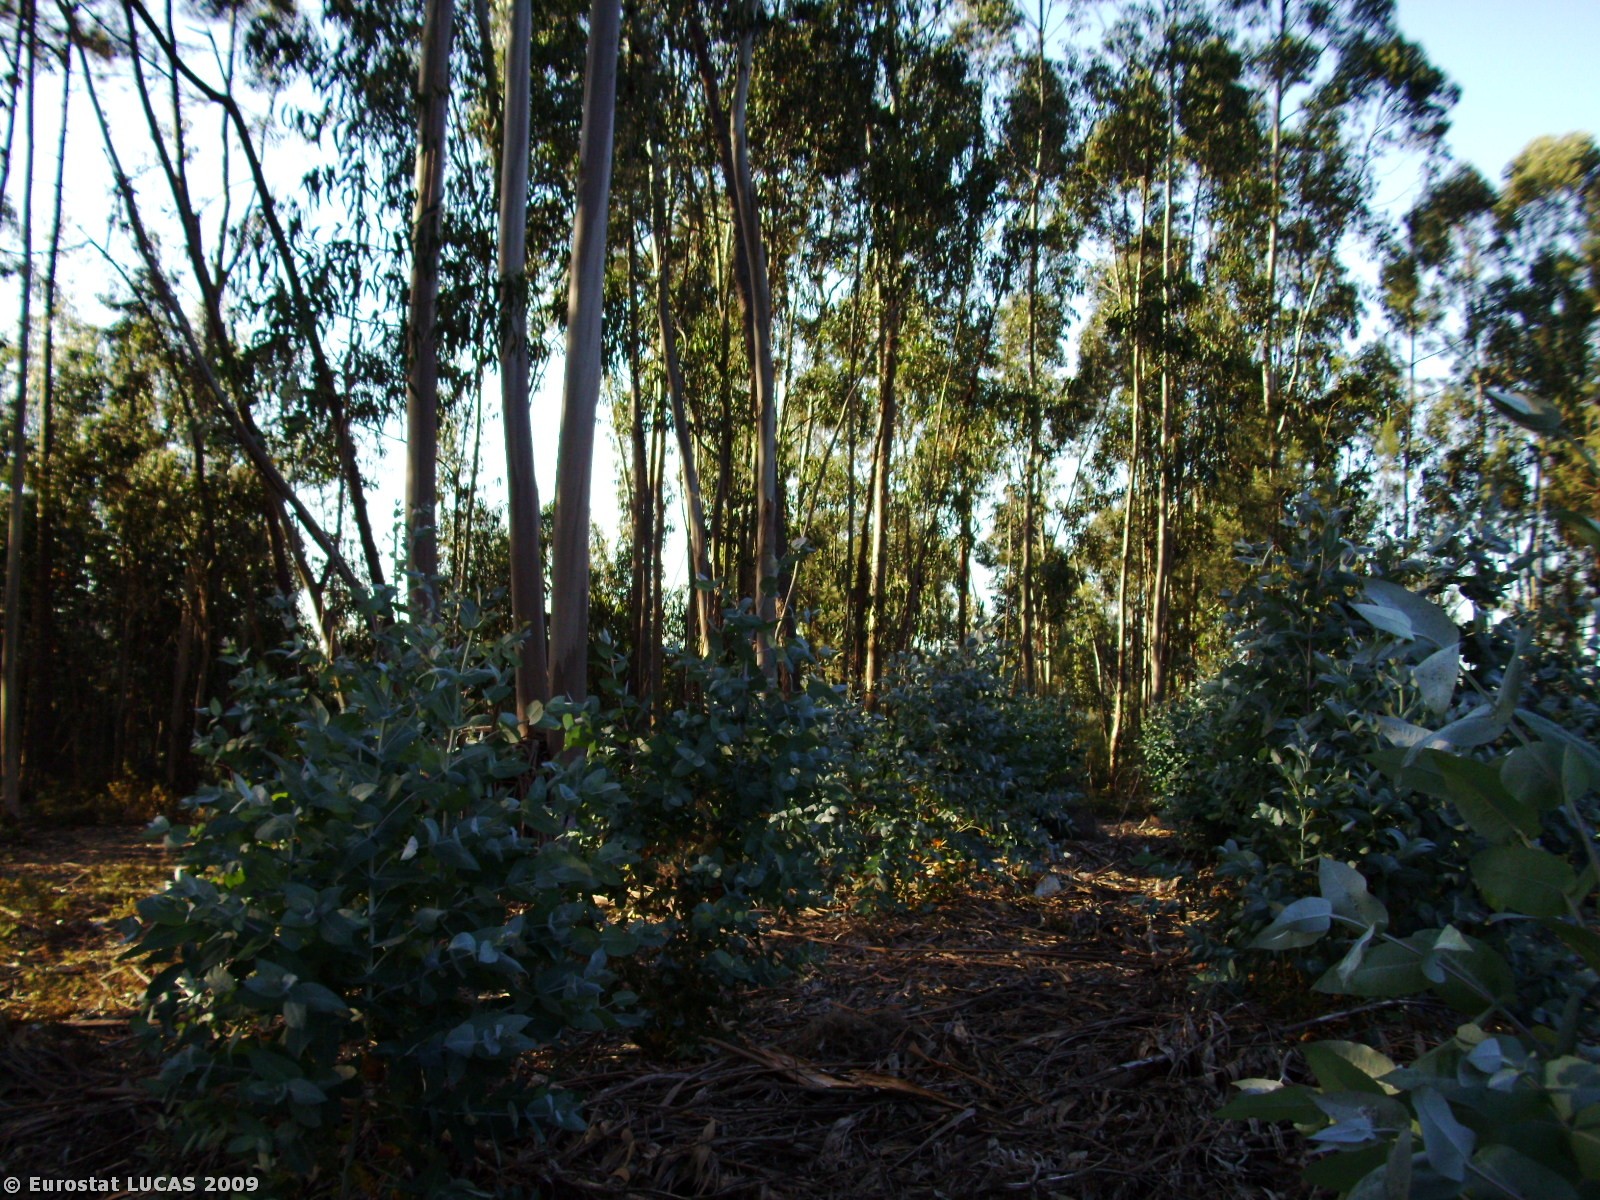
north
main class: Woodland
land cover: Broadleaved woodland
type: plantations and self-sown exotic forest
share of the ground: > 75 %
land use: Forestry
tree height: > 5 m
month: May
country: PT
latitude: 40.6183
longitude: -8.3999
